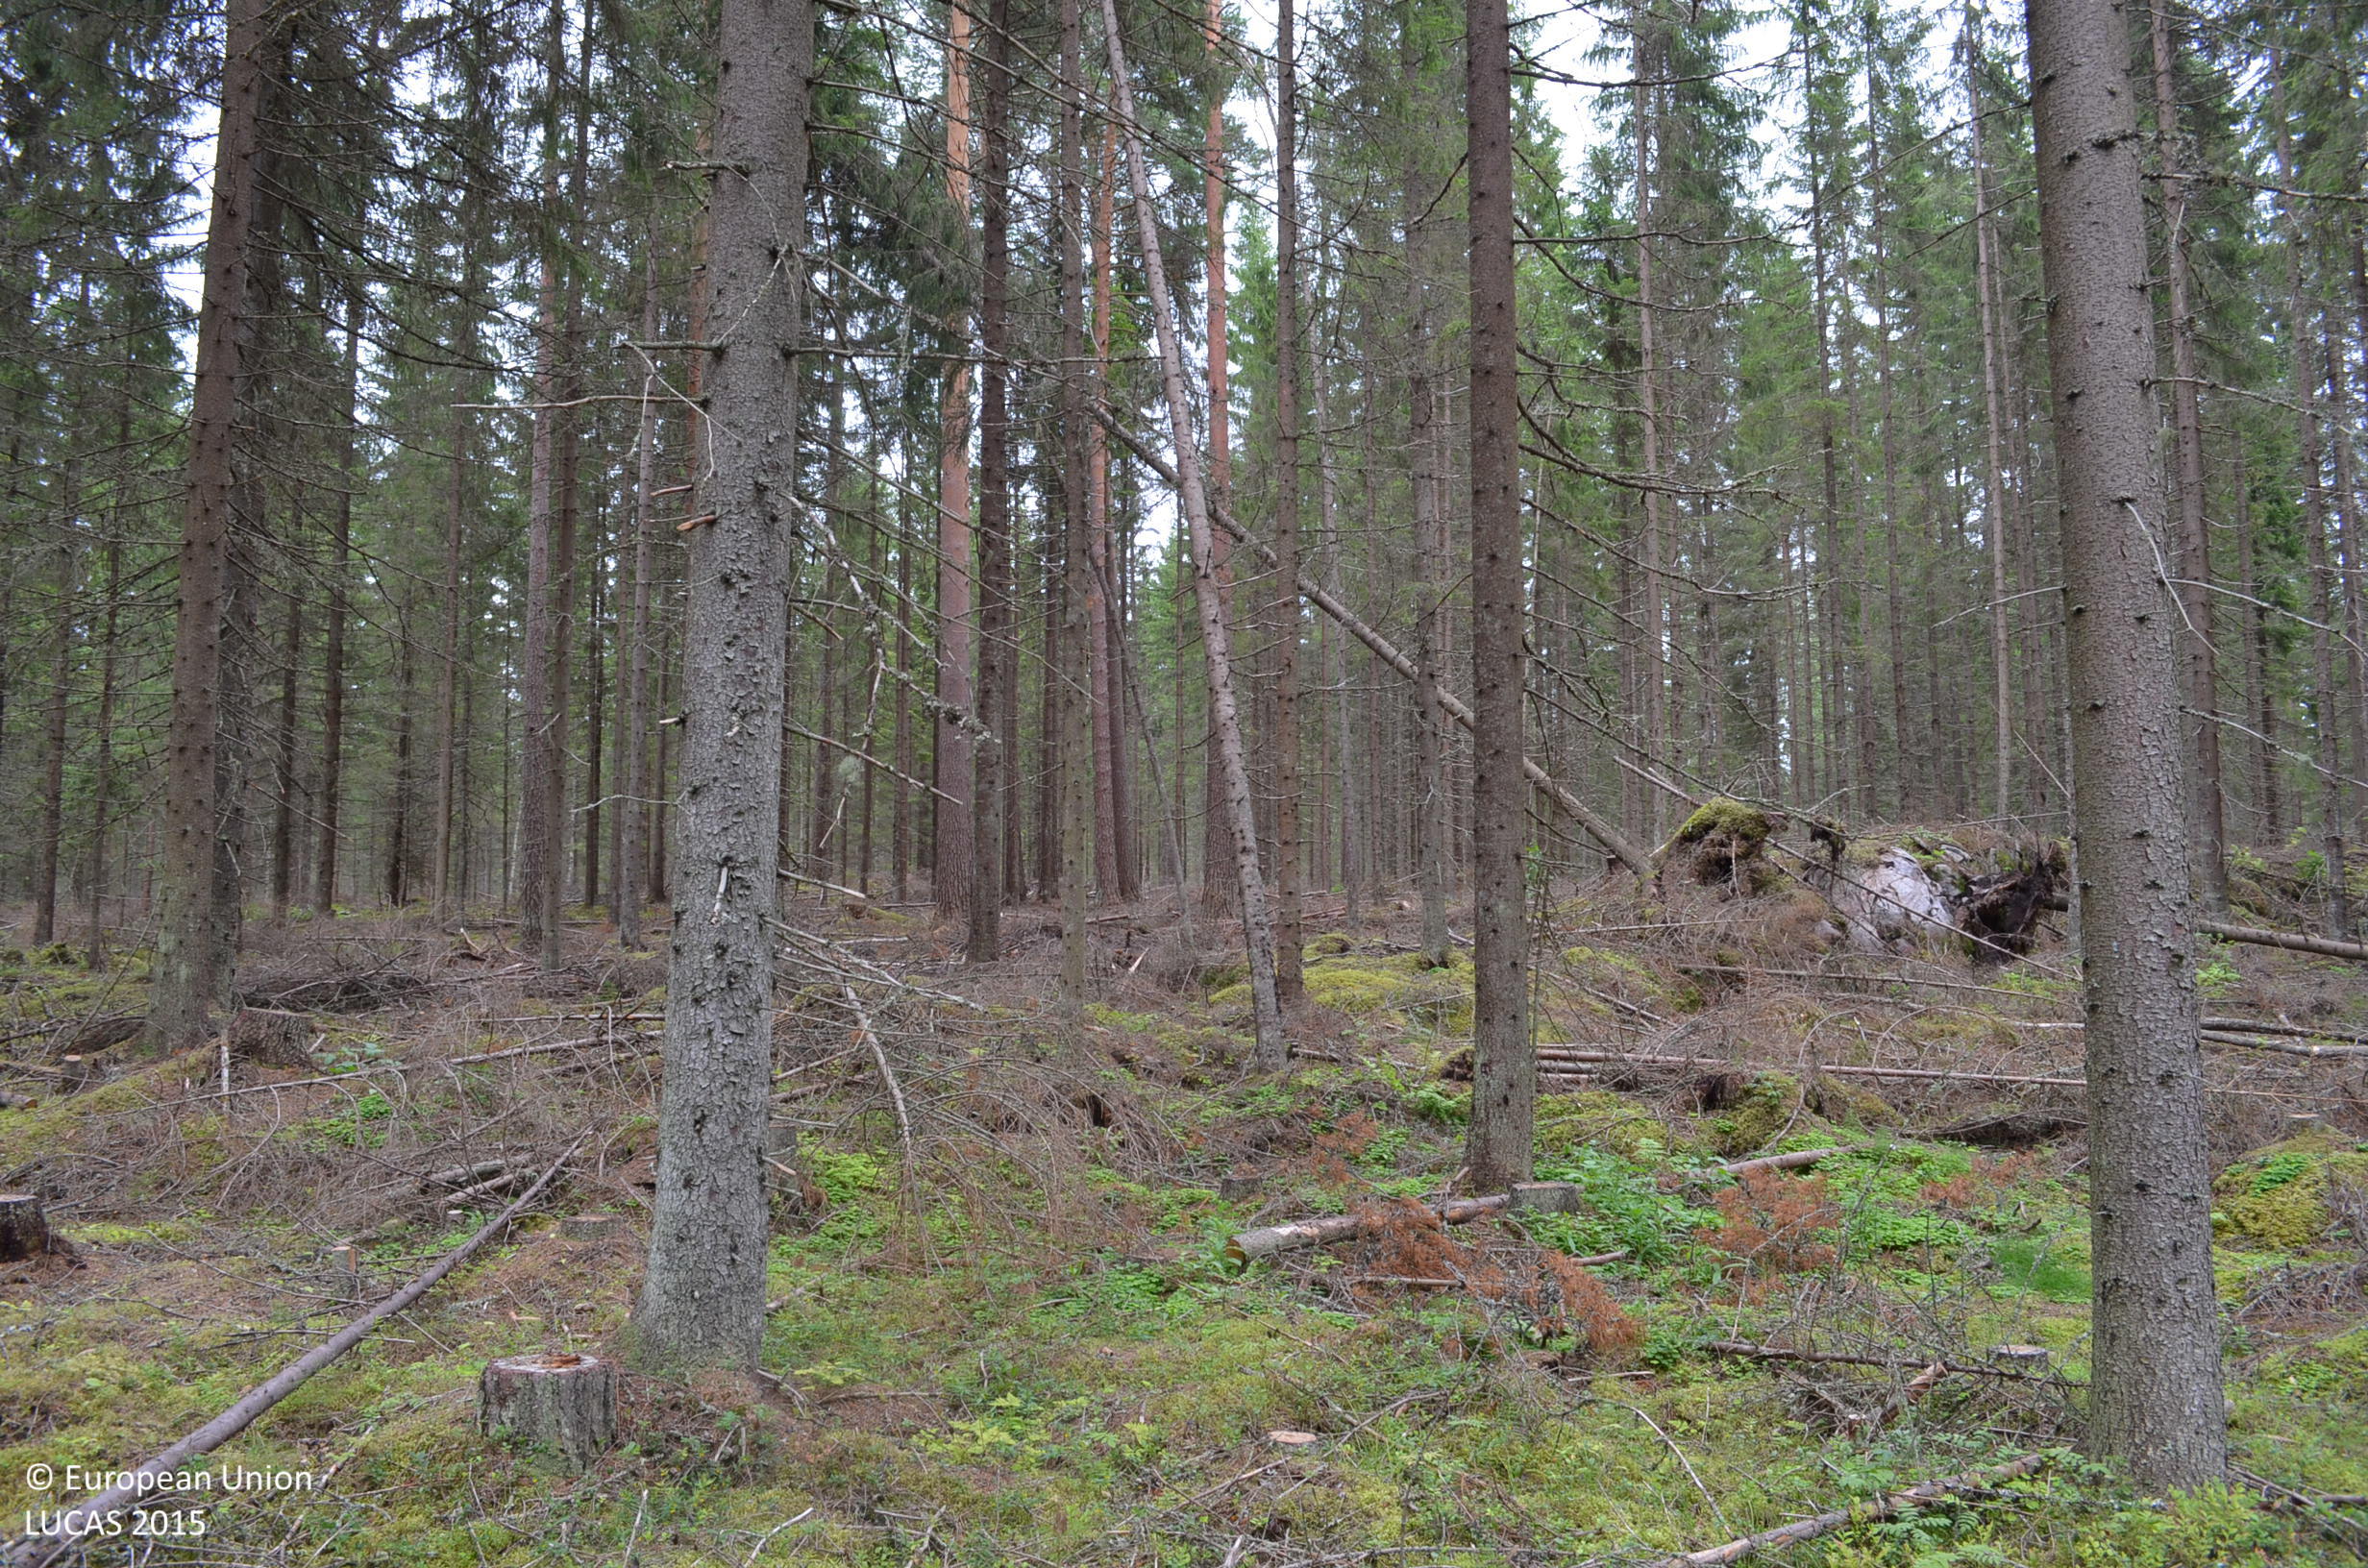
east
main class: Woodland
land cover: Spruce dominated coniferous woodland
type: boreal forest
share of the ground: 50 - 75 %
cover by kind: coniferous forest trees 65 %, shrubs 10 %, herbaceous plants 5 %, lichens and mosses 5 %
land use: Forestry
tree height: > 5 m
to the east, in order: Spruce dominated coniferous woodland; Ditches and canals; Other coniferous woodland; Spruce dominated mixed woodland
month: August
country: FI
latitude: 61.8919
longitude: 24.0711
